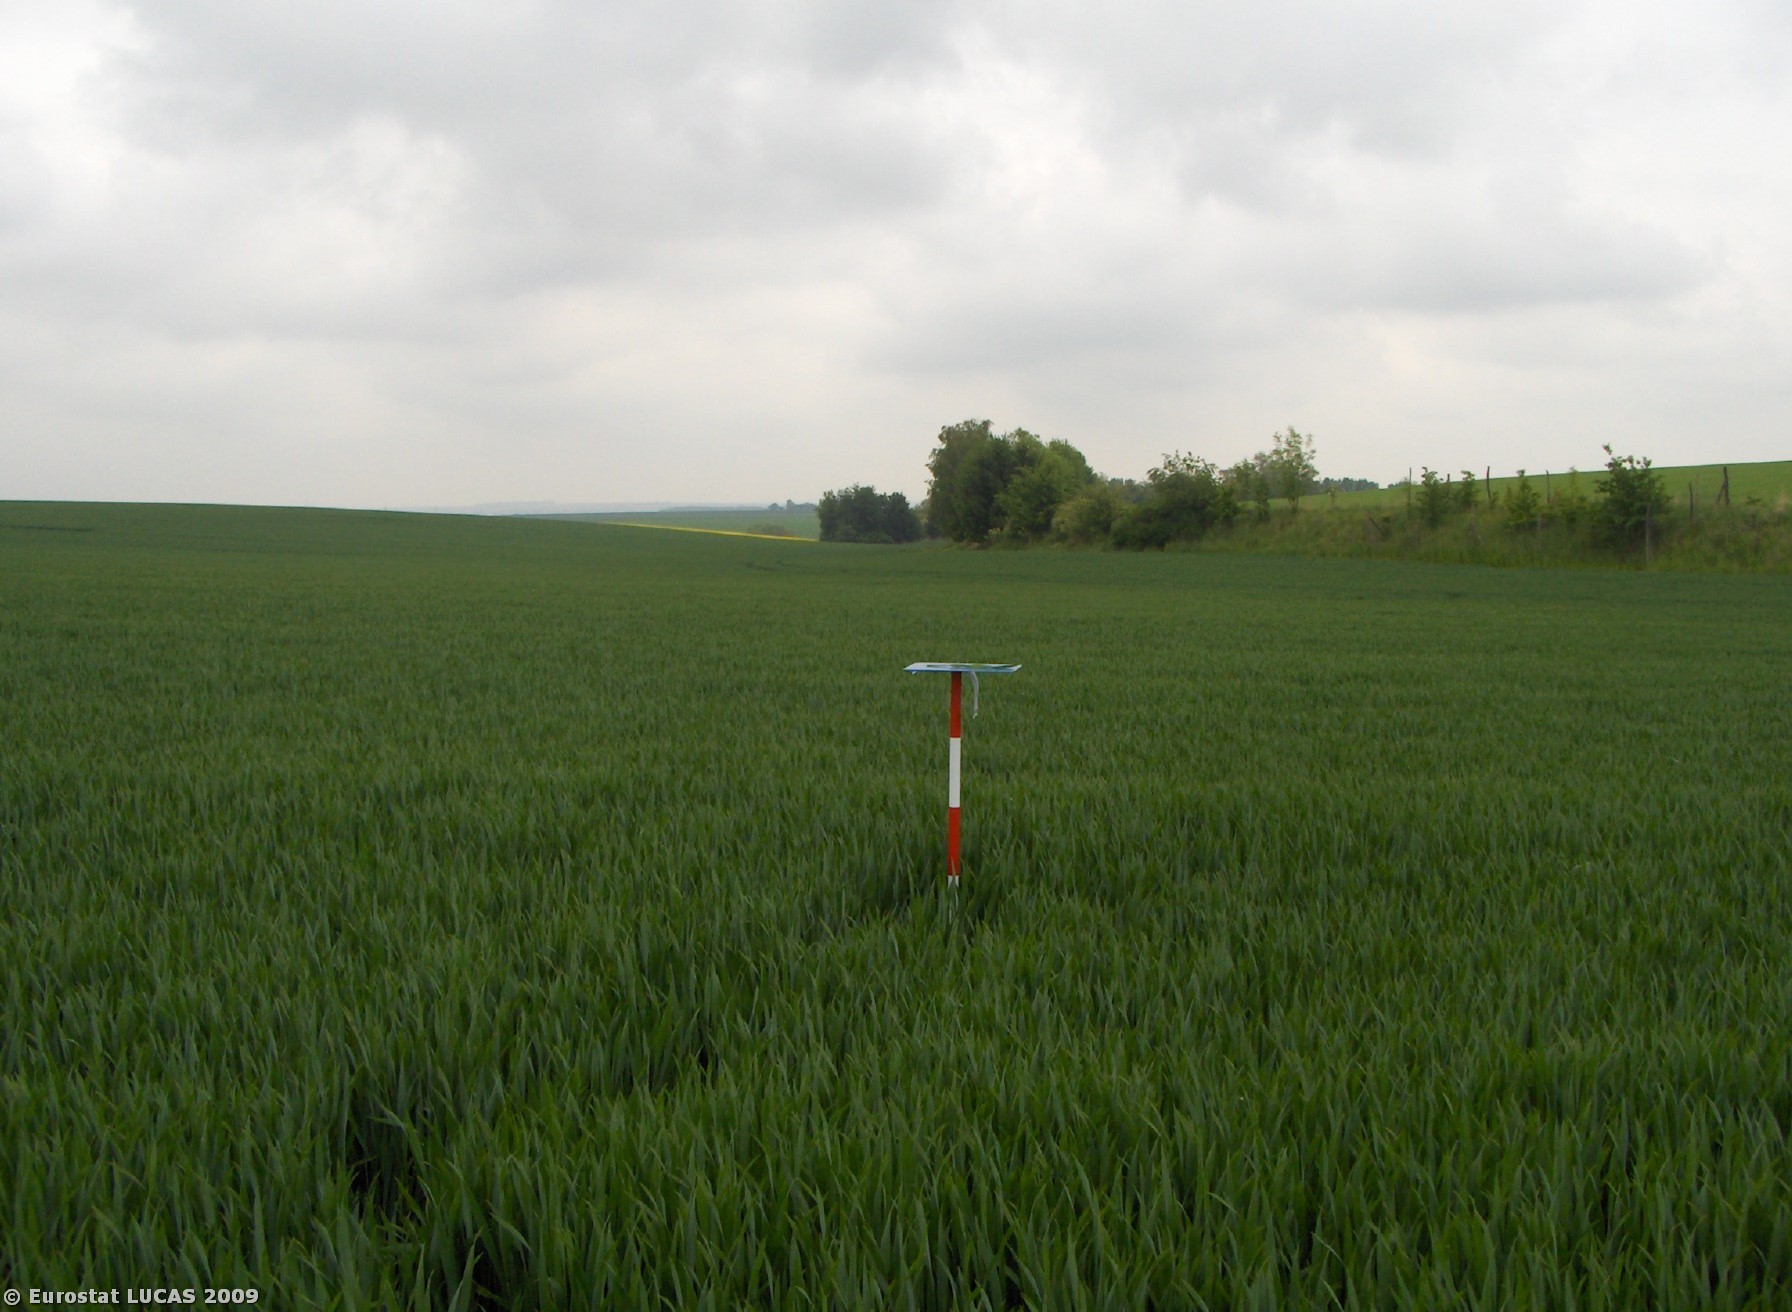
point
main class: Cropland
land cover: Common wheat
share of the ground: > 75 %
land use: Agriculture (excluding fallow land and kitchen gardens)
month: May
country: CZ
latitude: 49.3992
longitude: 17.1617
